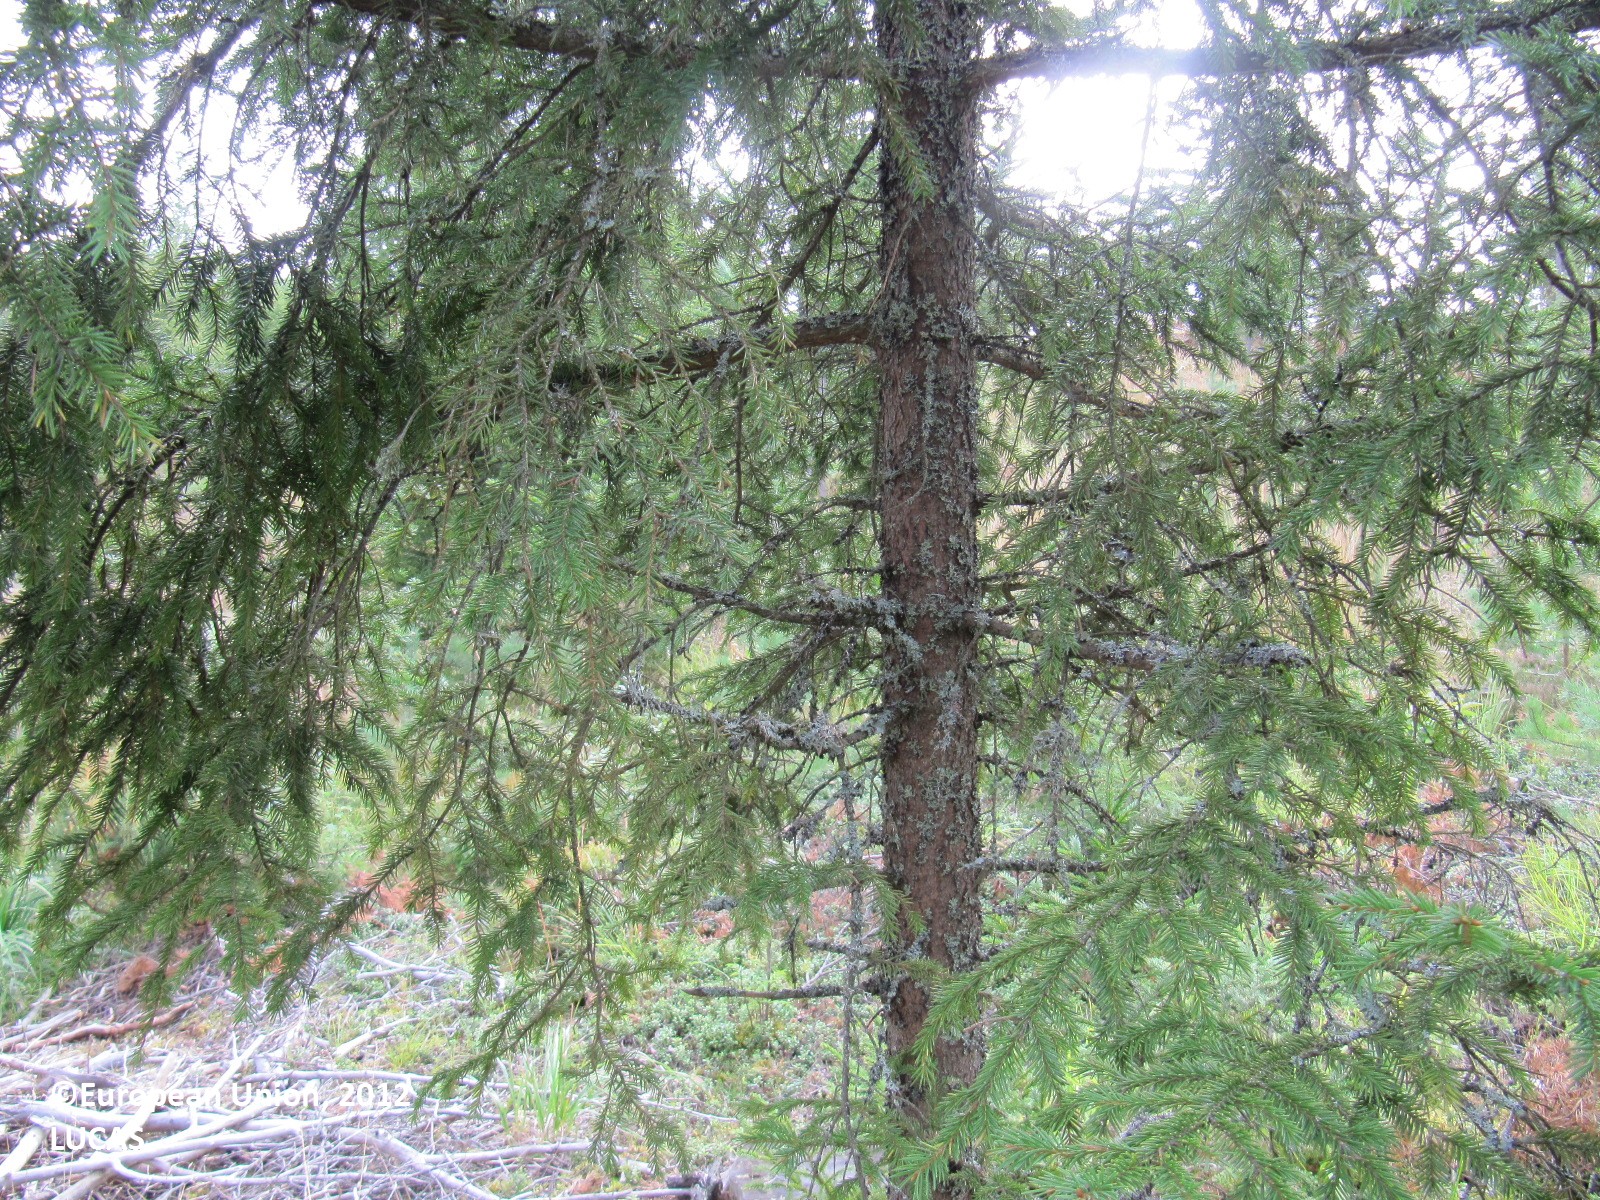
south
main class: Woodland
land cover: Spruce dominated mixed woodland
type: boreal forest
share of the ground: 50 - 75 %
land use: Forestry
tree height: > 5 m
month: August
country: FI
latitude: 61.1036
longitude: 22.8911
